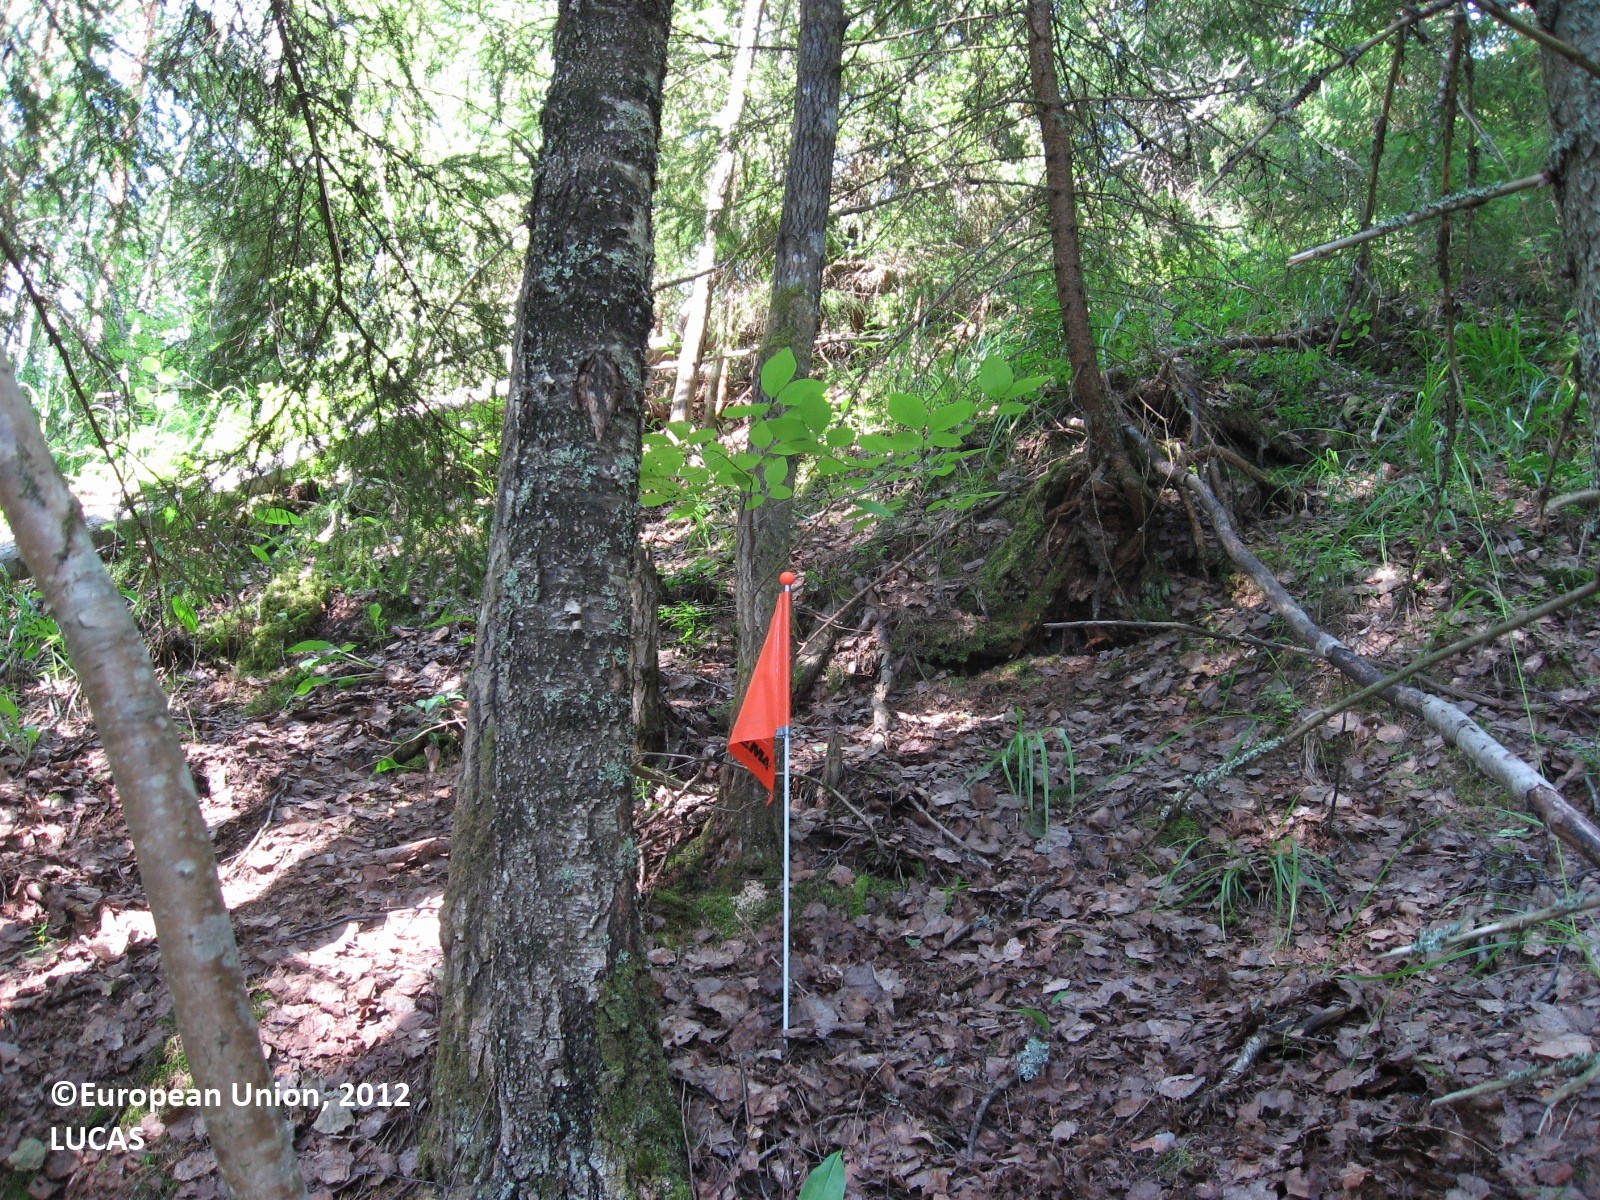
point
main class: Woodland
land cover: Spruce dominated mixed woodland
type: boreal forest
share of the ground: > 75 %
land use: Forestry
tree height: > 5 m
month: July
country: FI
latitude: 60.8404
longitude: 26.5099
